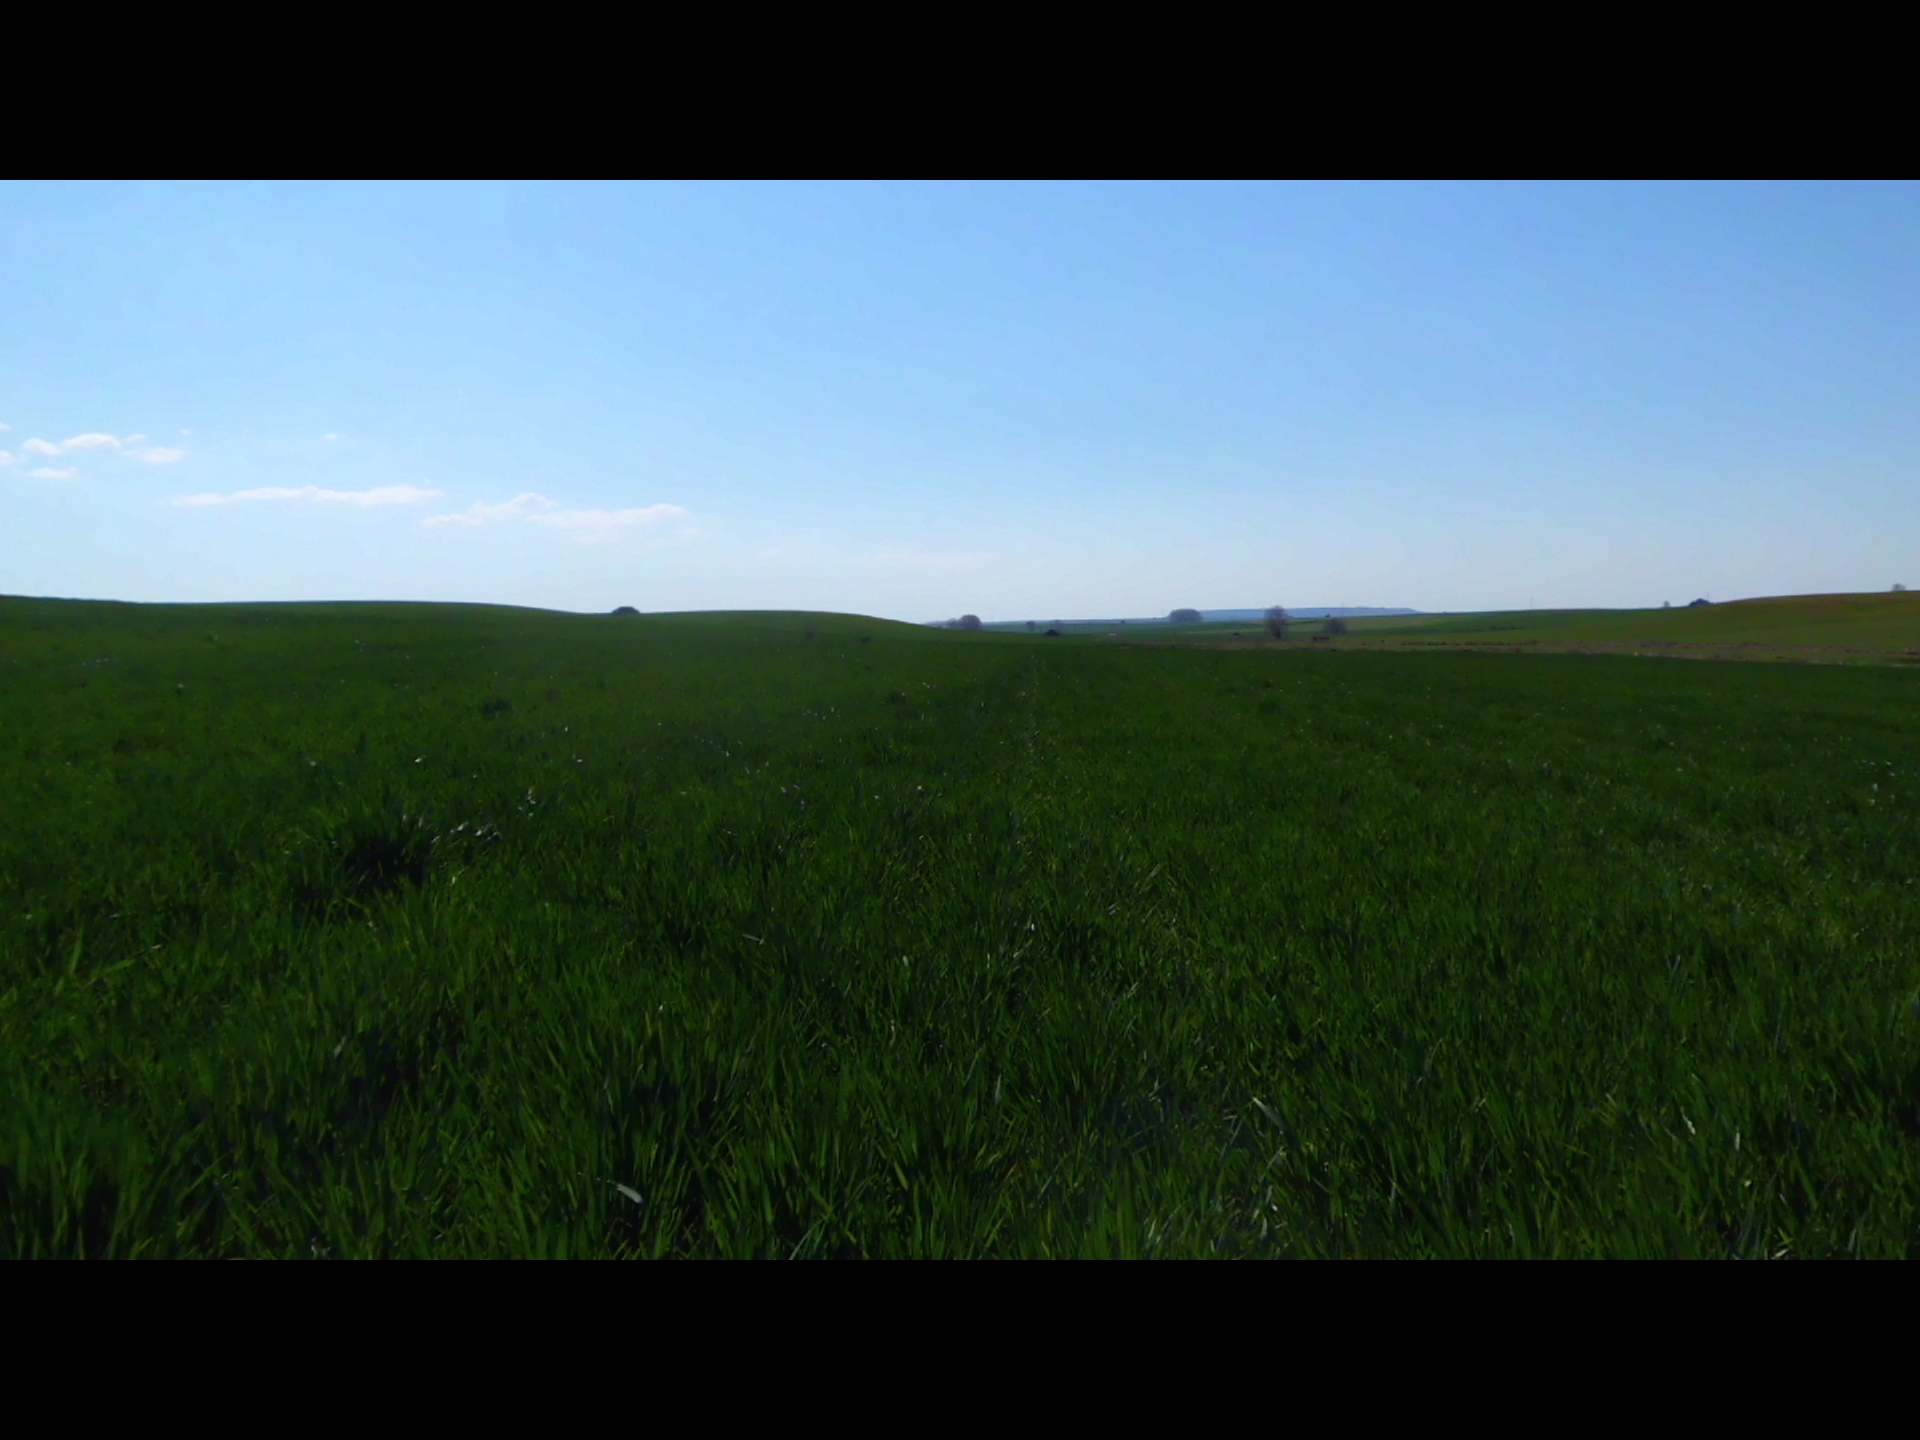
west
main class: Cropland
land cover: Common wheat
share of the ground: > 75 %
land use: Agriculture (excluding fallow land and kitchen gardens)
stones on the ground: < 10 %
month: April
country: ES
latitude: 42.2251
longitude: -3.7383
